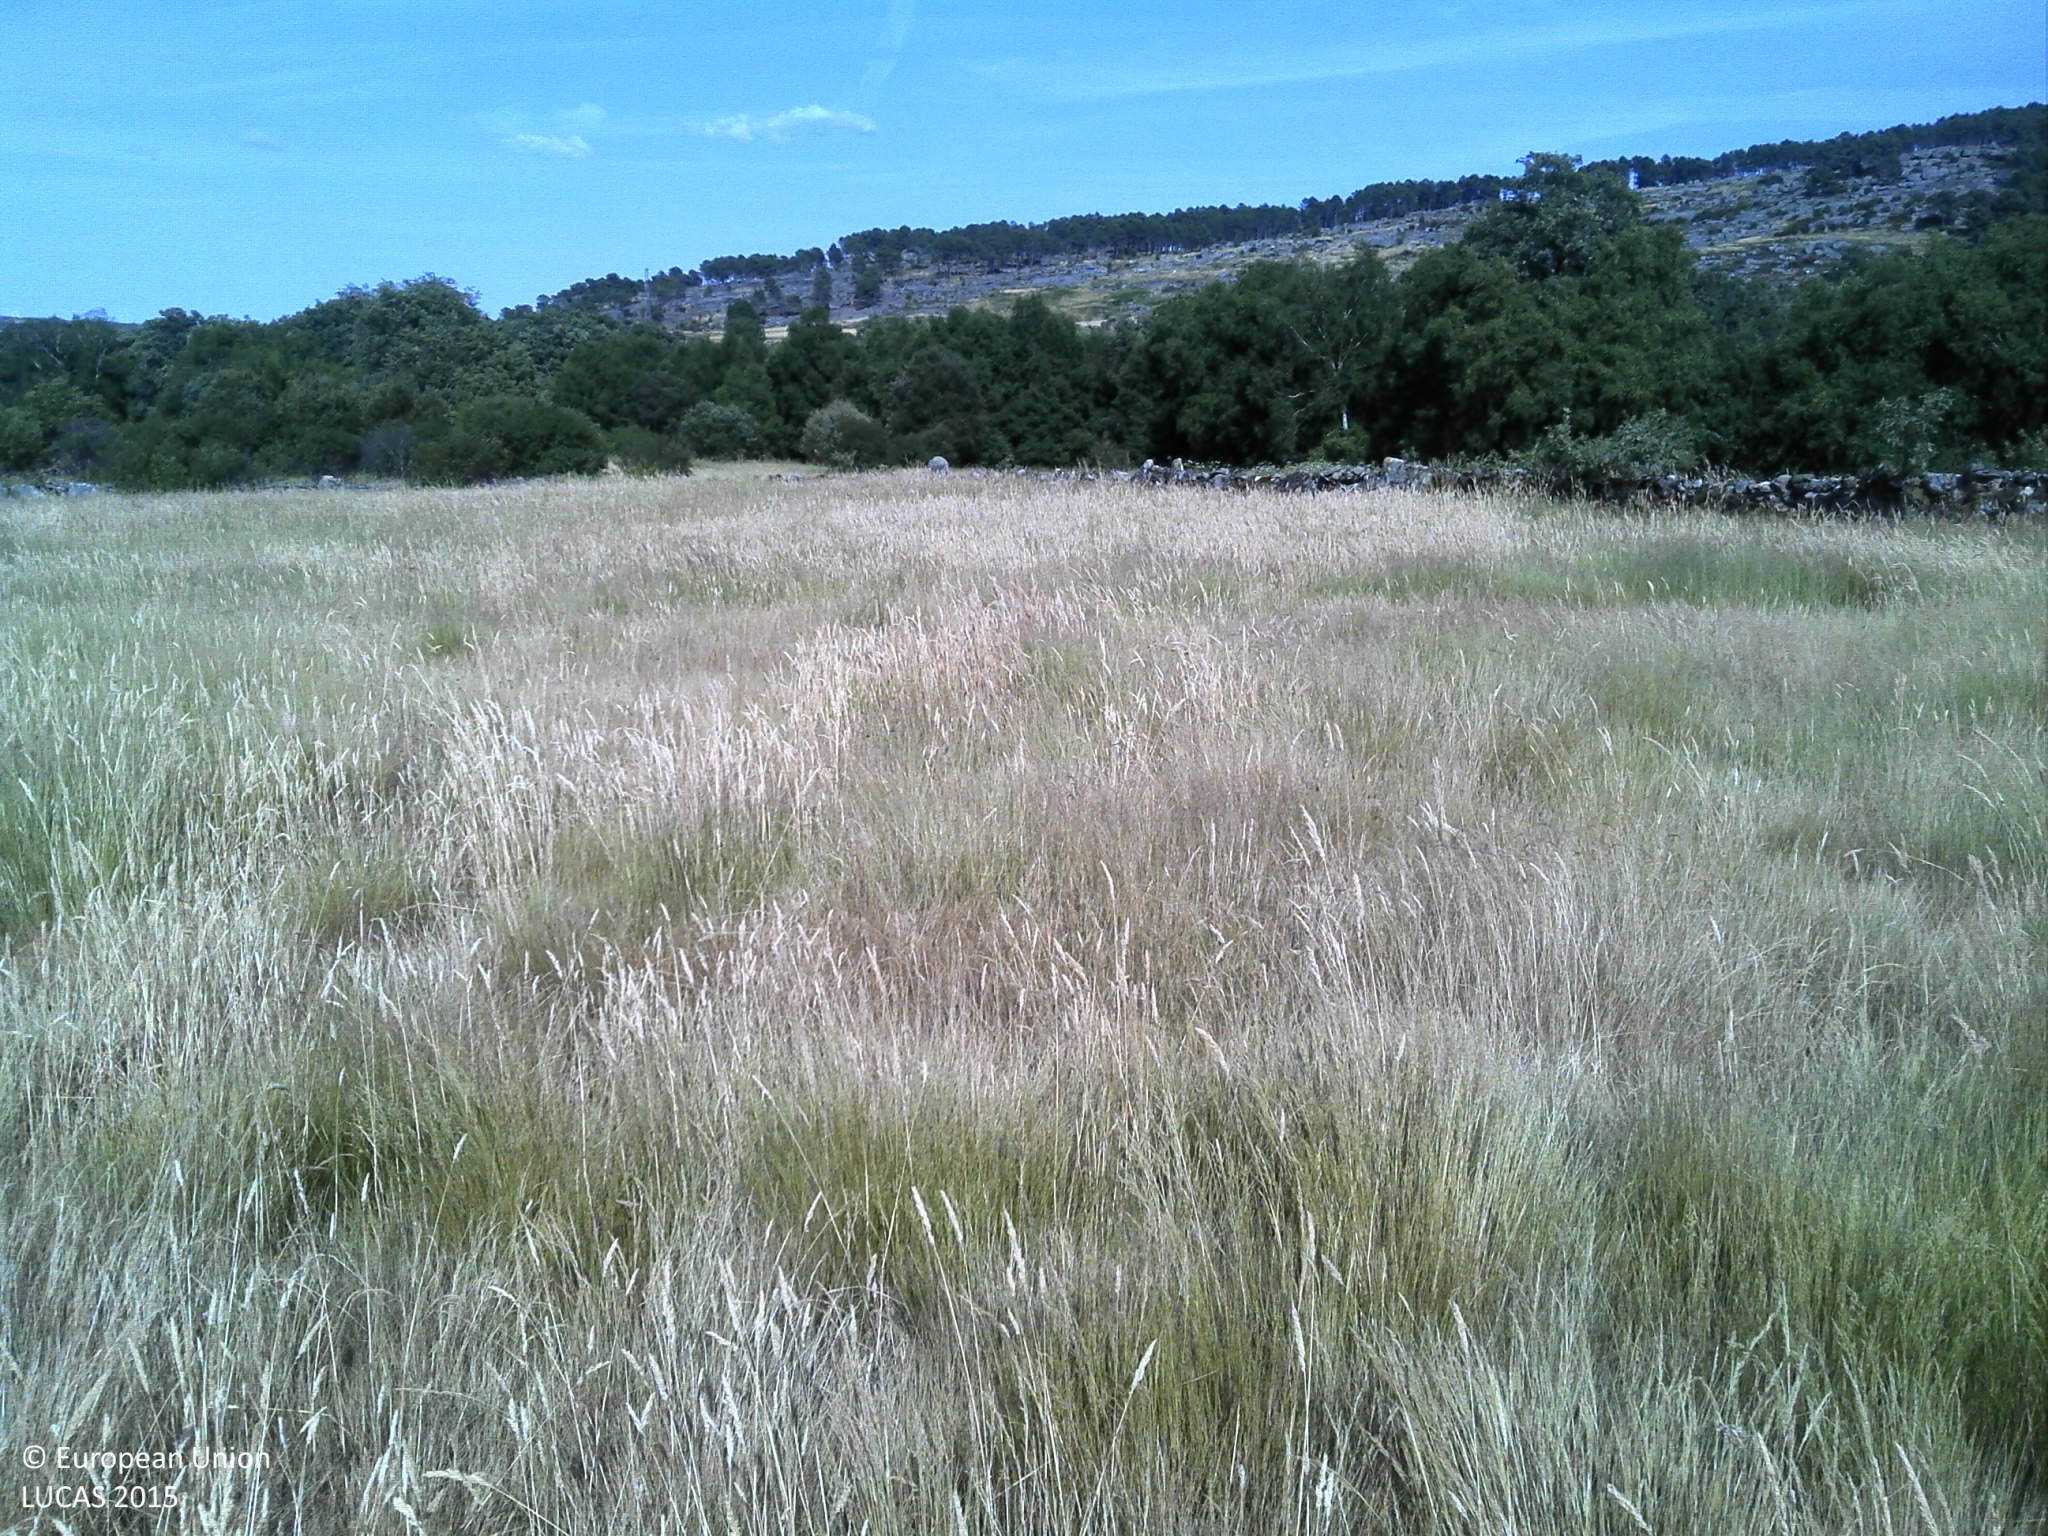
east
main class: Grassland
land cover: Grassland without tree/shrub cover
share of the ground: > 75 %
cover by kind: herbaceous plants 90 %, unconsolidated bare surface 10 %
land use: Agriculture (excluding fallow land and kitchen gardens)
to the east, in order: Grassland without tree/shrub cover; Dry stone walls; Grassland without tree/shrub cover; Dry stone walls; Temporary grasslands; Dry stone walls; Spontaneously vegetated surfaces; Fences; Broadleaved woodland; Rivers and streams; Shrubland with sparse tree cover
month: July
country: PT
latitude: 41.4816
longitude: -7.7258
